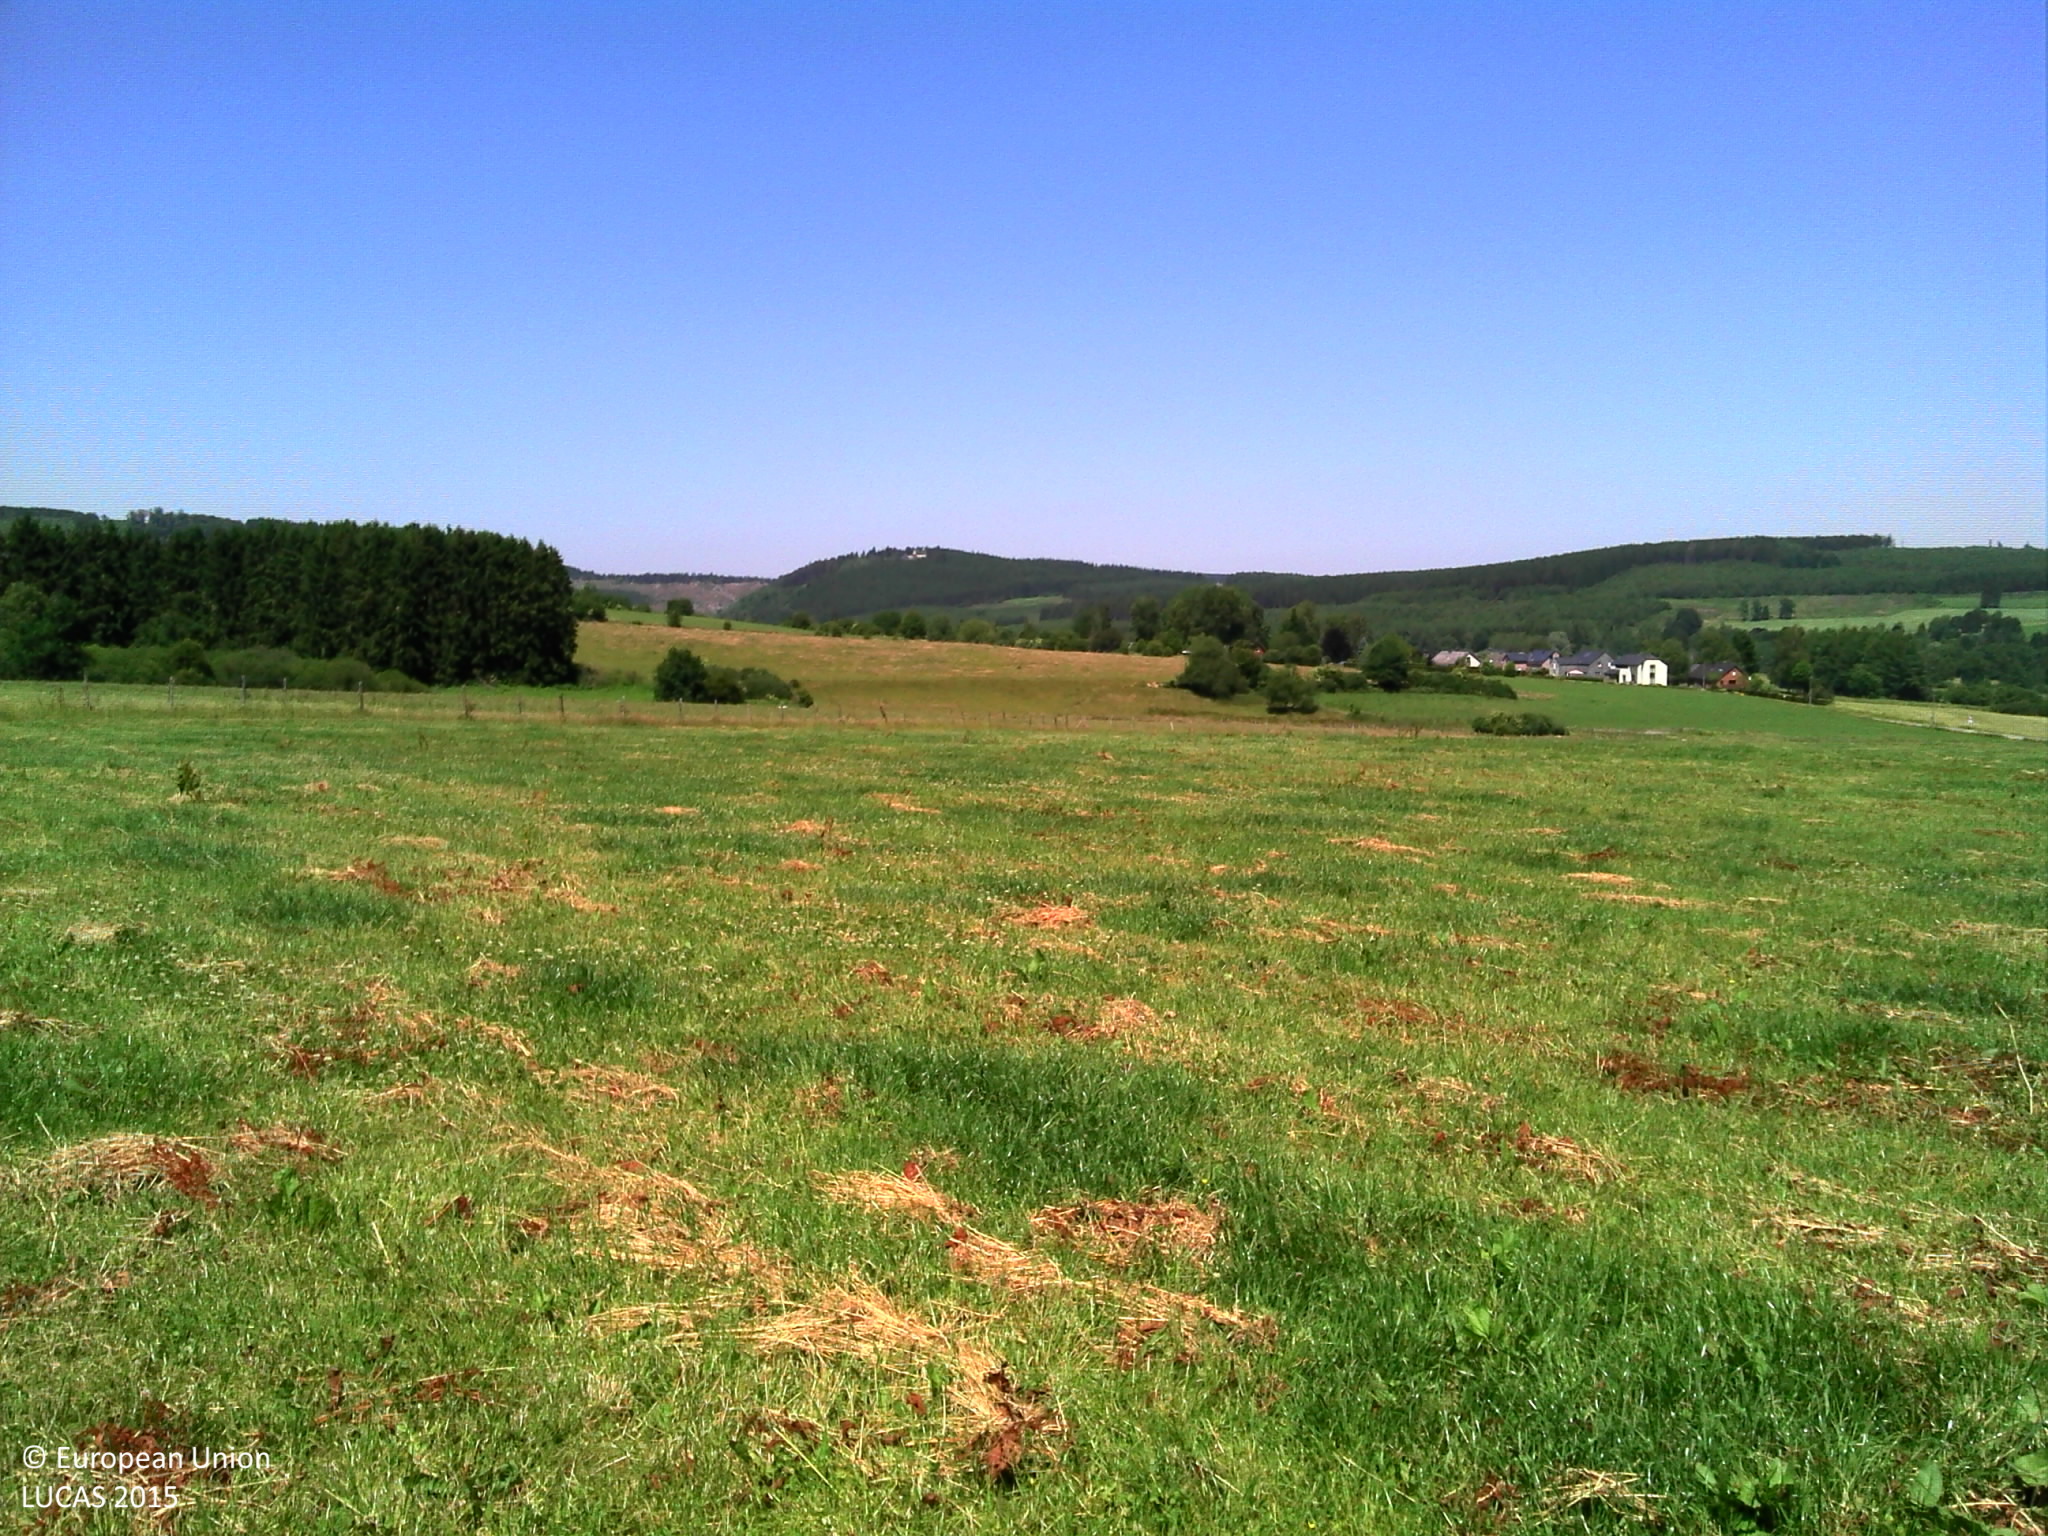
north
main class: Grassland
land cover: Grassland without tree/shrub cover
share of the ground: > 75 %
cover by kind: herbaceous plants 100 %
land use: Agriculture (excluding fallow land and kitchen gardens)
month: June
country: BE
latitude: 50.0421
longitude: 5.5161
